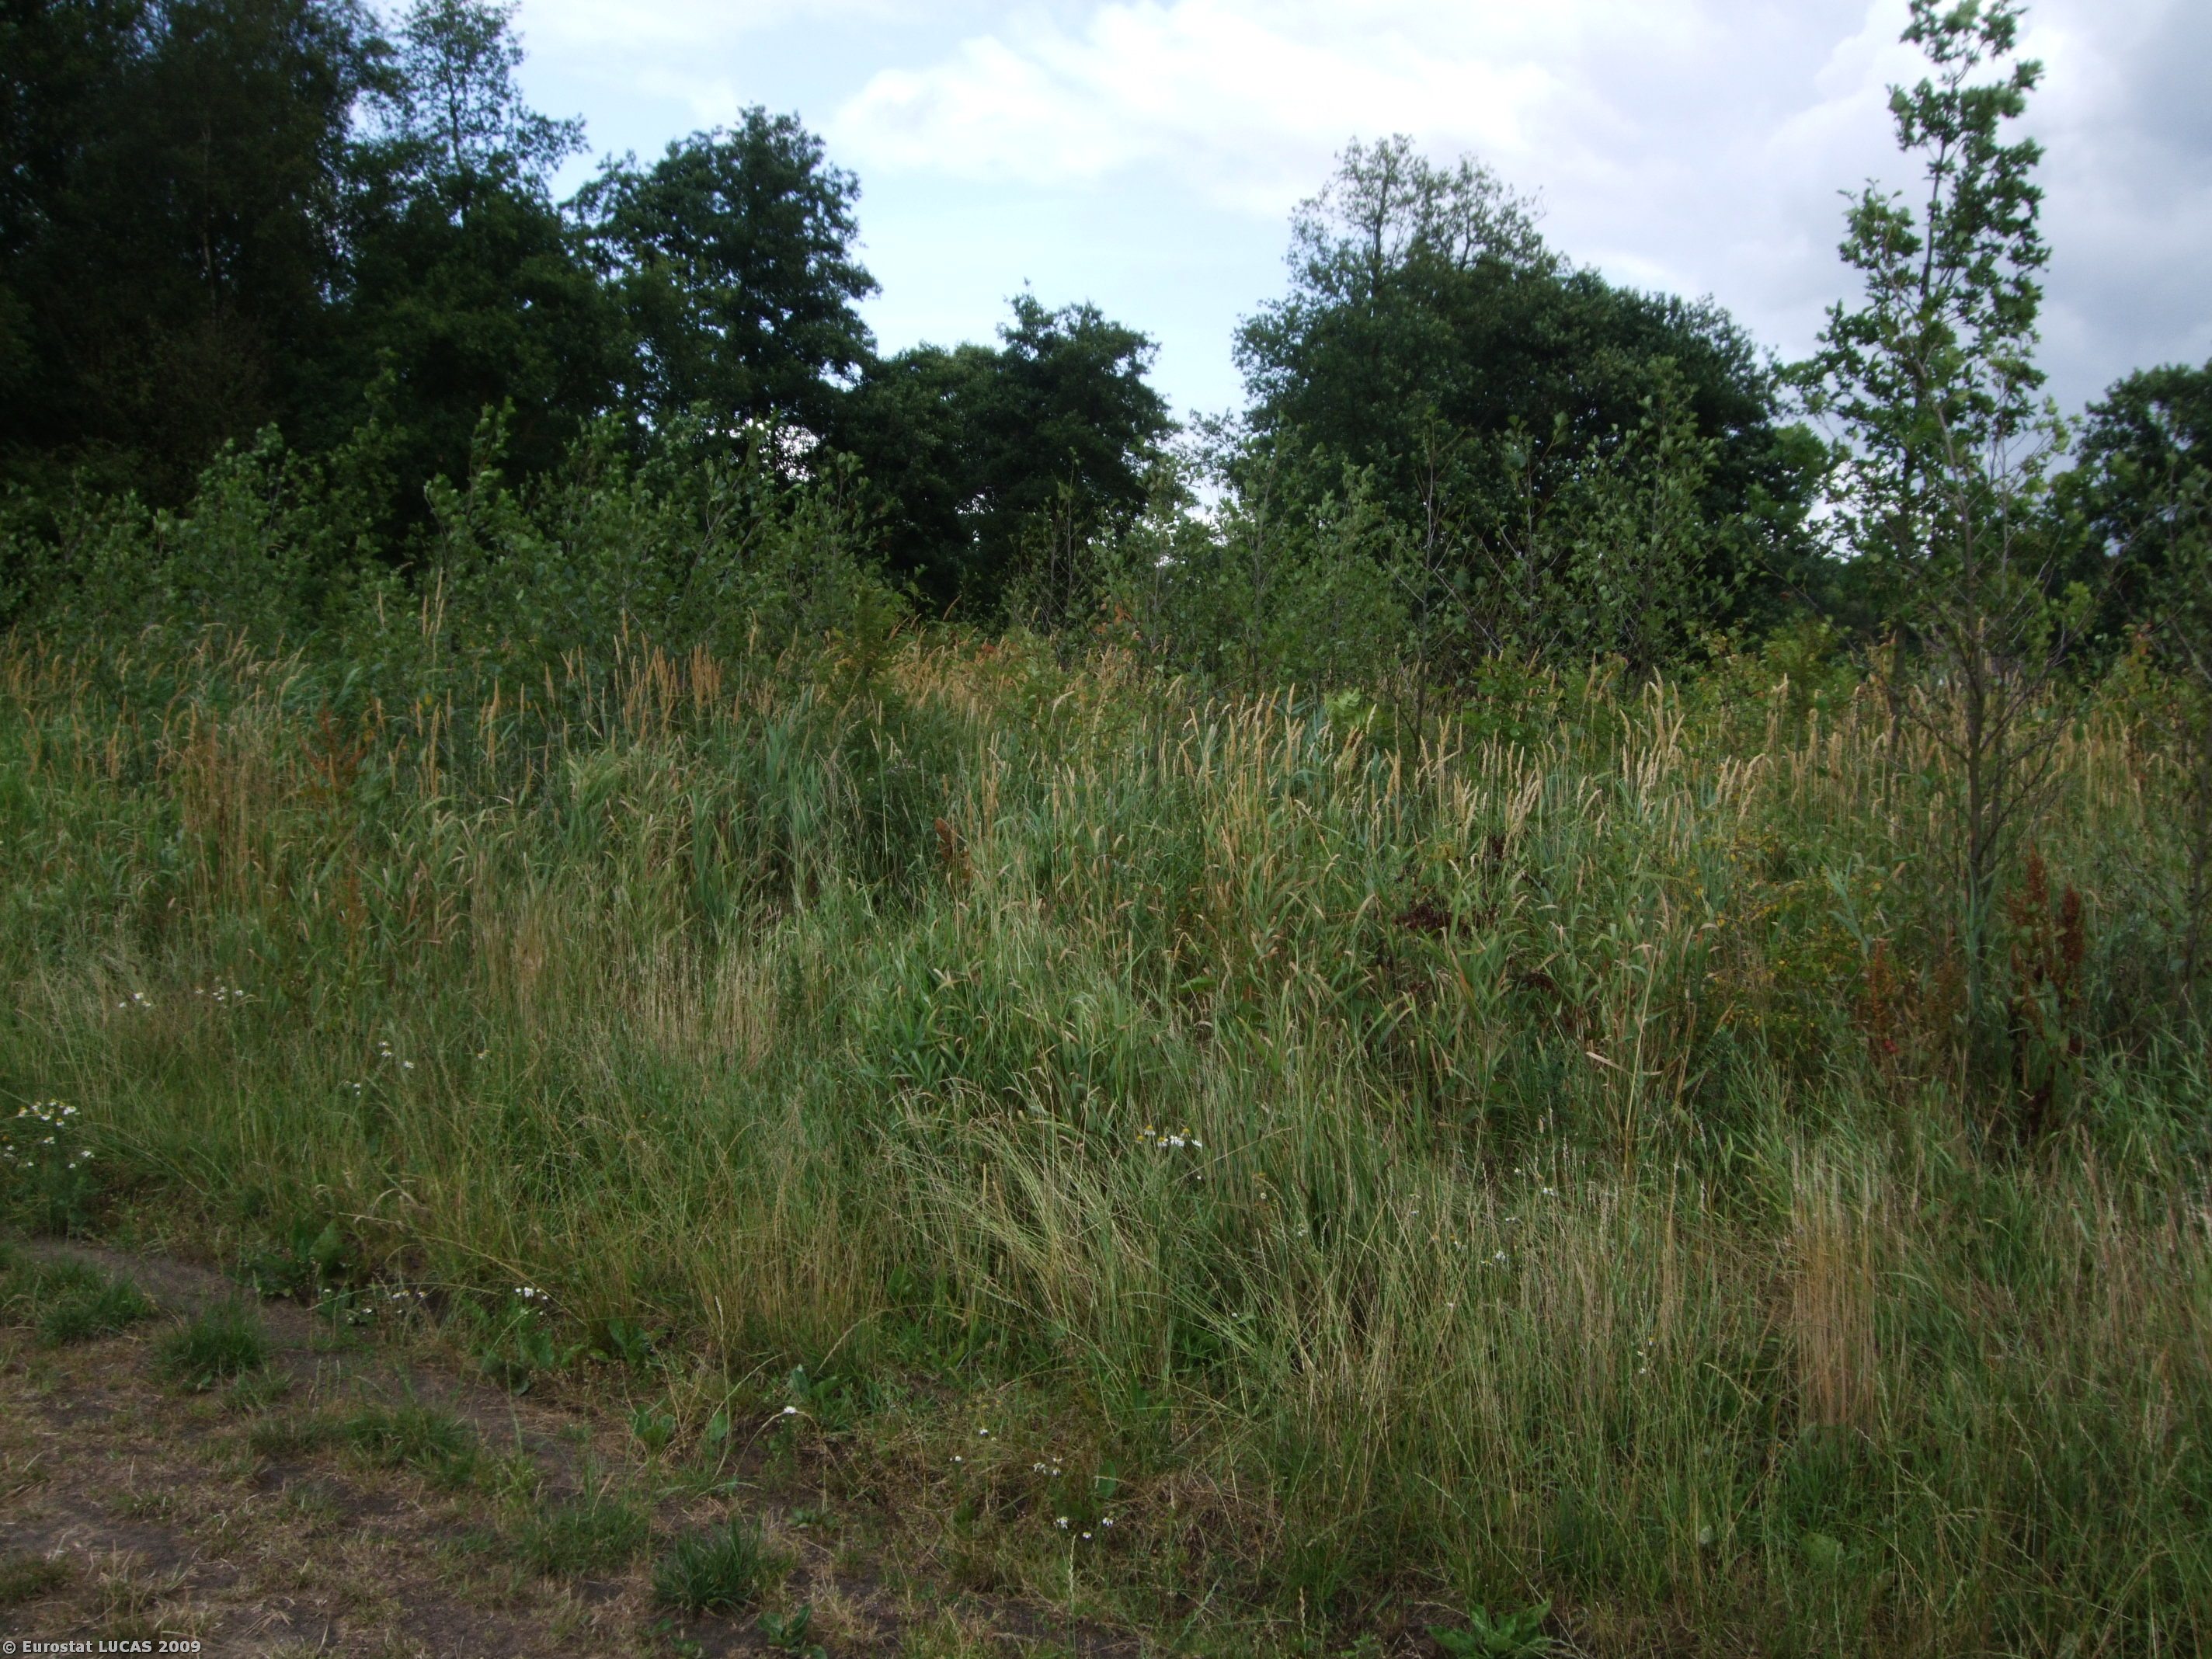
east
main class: Grassland
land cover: Grassland without tree/shrub cover
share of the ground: > 75 %
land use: Agriculture (excluding fallow land and kitchen gardens)
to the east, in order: Grassland without tree/shrub cover; Inland running water; Grassland without tree/shrub cover; Broadleaved woodland; Inland running water; Grassland without tree/shrub cover; Broadleaved woodland; Inland running water; Broadleaved woodland; Tracks; Grass margins; Ditches and canals; Fences; Grassland without tree/shrub cover
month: July
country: NL
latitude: 51.3371
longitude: 5.4765
